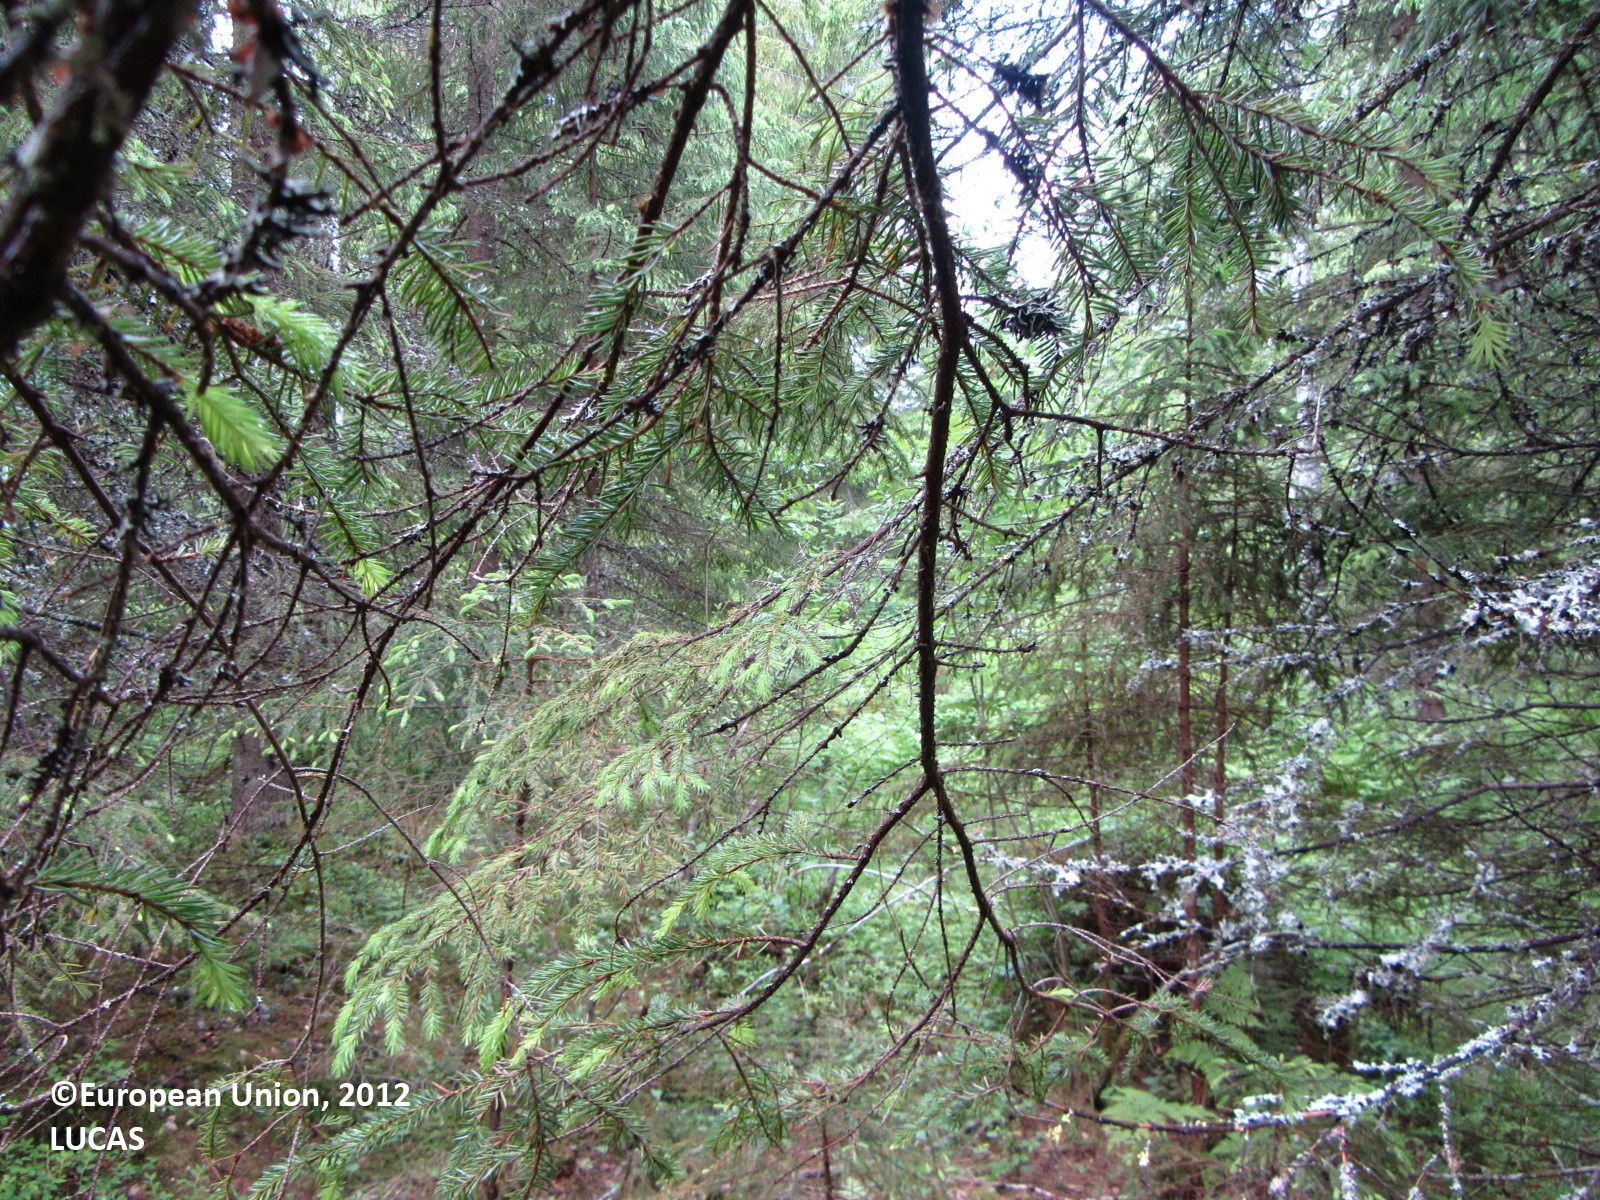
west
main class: Woodland
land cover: Spruce dominated coniferous woodland
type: boreal forest
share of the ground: > 75 %
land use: Forestry
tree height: > 5 m
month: June
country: FI
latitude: 62.4345
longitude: 25.2739
